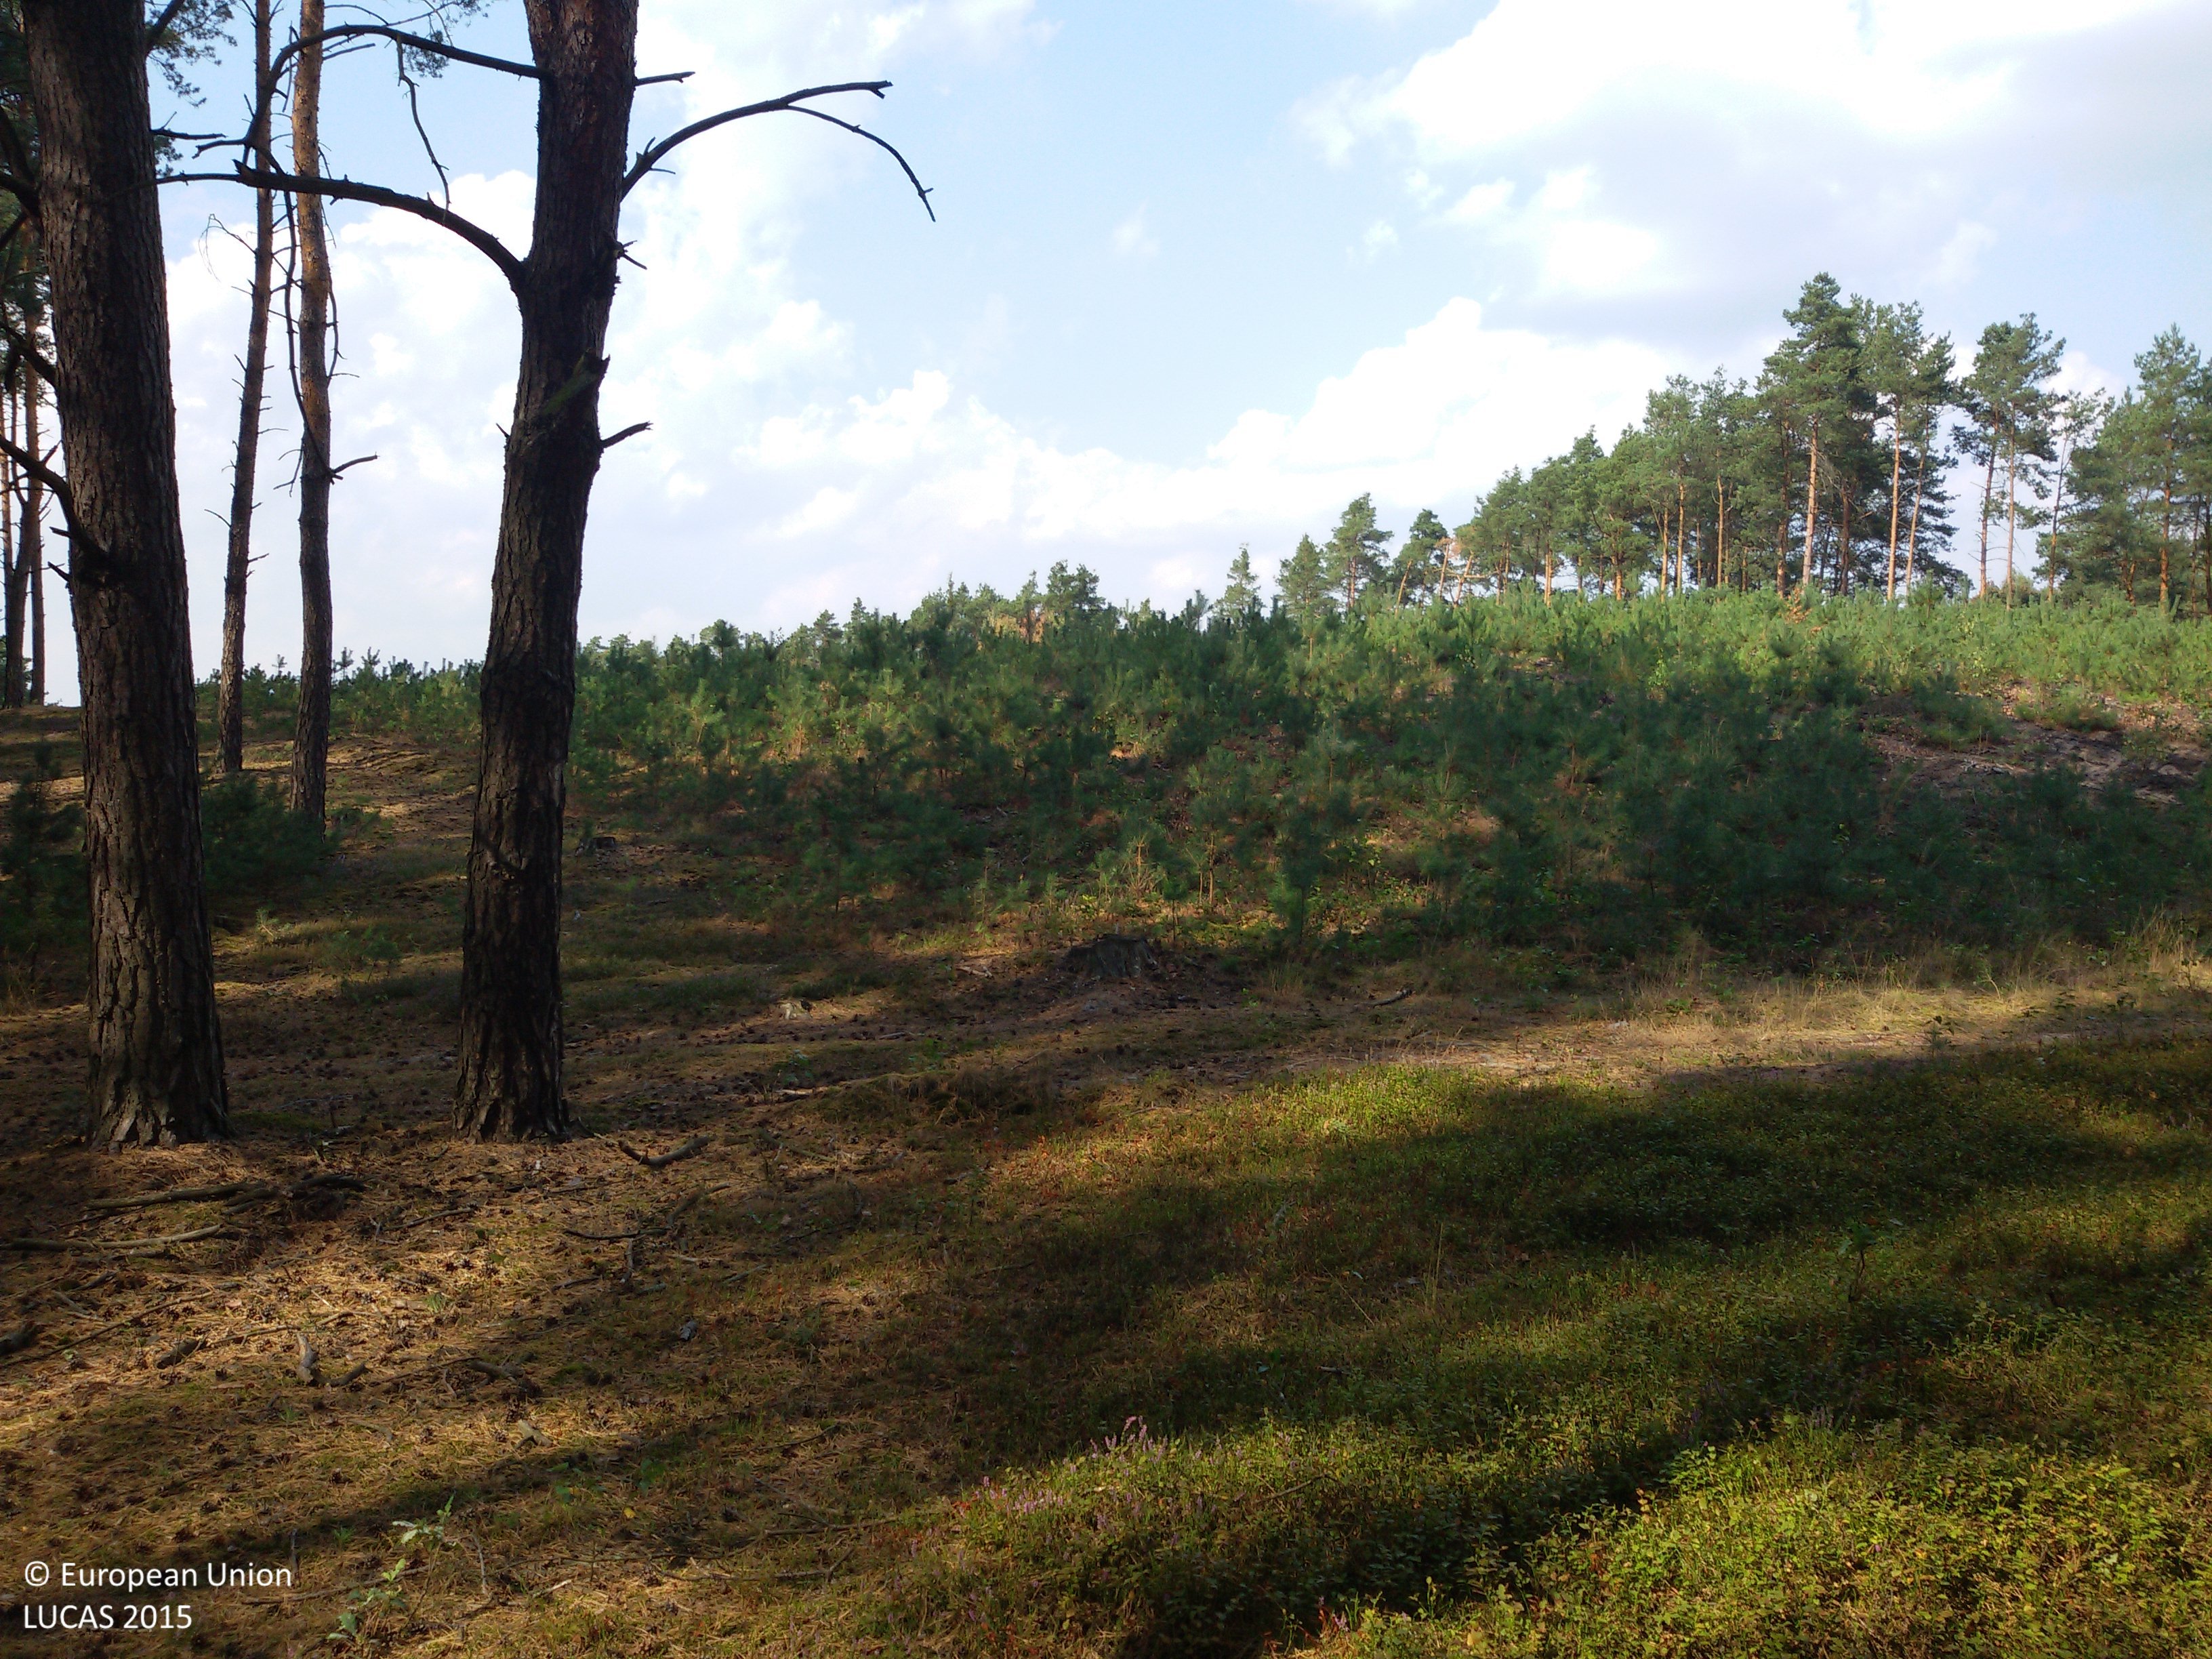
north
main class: Woodland
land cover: Pine dominated coniferous woodland
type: hemiboreal forest and nemoral coniferous forest and mixed broadleaved-coniferous forest
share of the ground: > 75 %
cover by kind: coniferous forest trees 70 %, broadleaved forest trees 10 %, shrubs 10 %, herbaceous plants 10 %
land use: Forestry
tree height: > 5 m
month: September
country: PL
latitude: 51.9682
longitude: 17.9189
